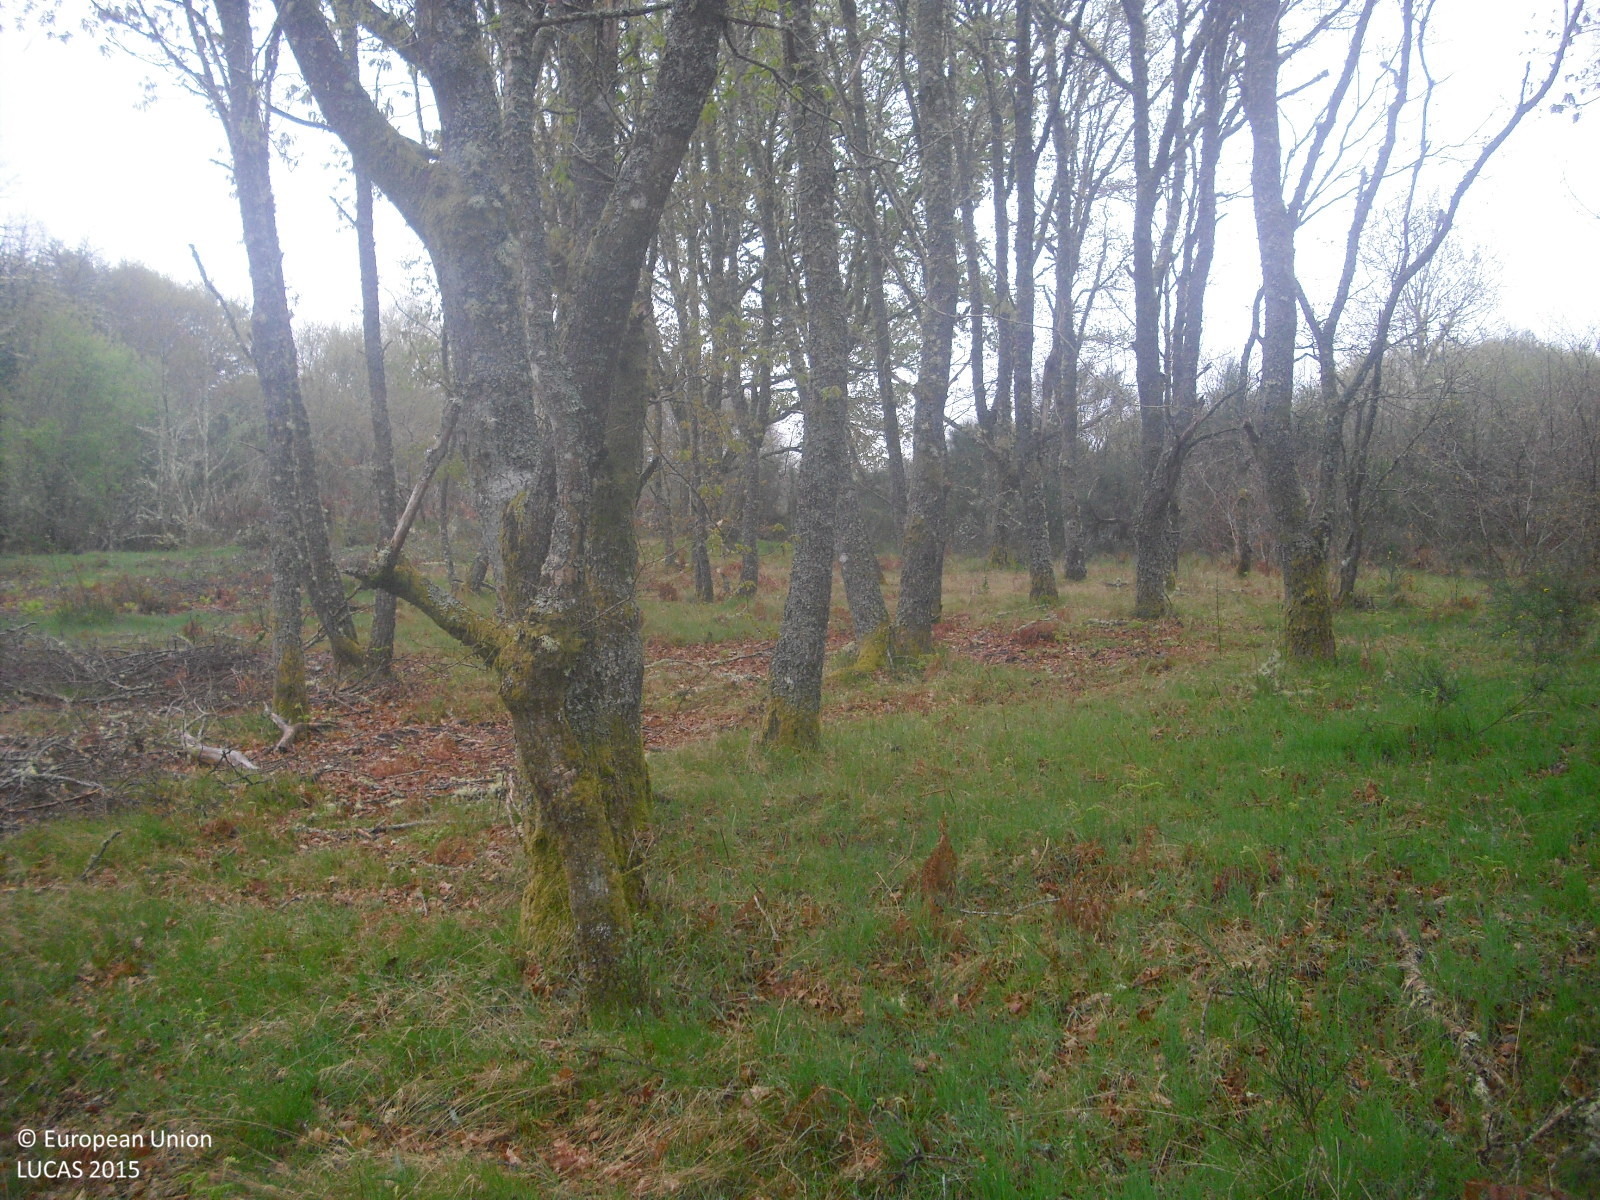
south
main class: Woodland
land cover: Broadleaved woodland
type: thermophilous deciduous forest
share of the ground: > 75 %
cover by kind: broadleaved forest trees 70 %, herbaceous plants 20 %, shrubs 10 %
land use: Forestry
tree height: > 5 m
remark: Clear cut
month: April
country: ES
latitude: 42.0768
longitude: -7.9034
